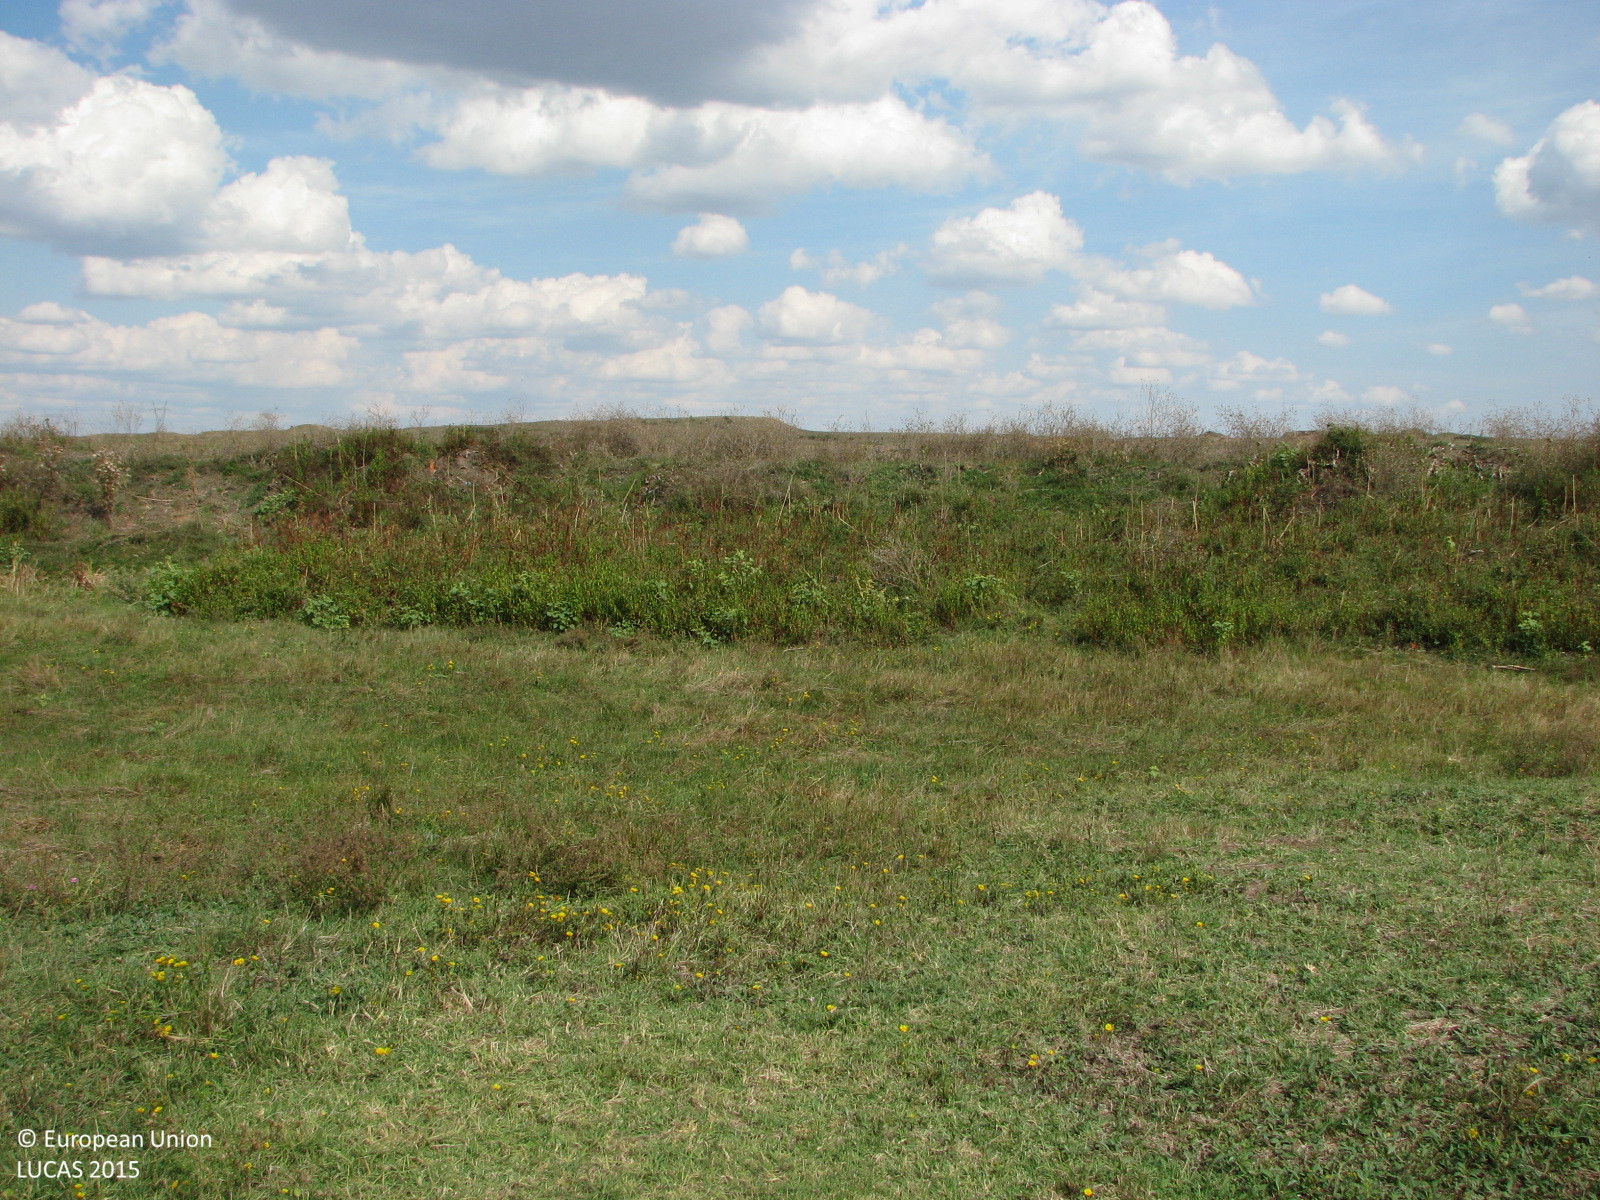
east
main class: Grassland
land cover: Grassland without tree/shrub cover
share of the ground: > 75 %
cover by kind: herbaceous plants 100 %
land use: Agriculture (excluding fallow land and kitchen gardens)
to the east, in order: Grassland without tree/shrub cover; Tracks; Grassland without tree/shrub cover; Inland fresh running water; Grassland without tree/shrub cover; Inland fresh water bodies; Grass margins; Other bare soil; Grassland without tree/shrub cover
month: September
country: BG
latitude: 42.5545
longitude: 26.7479
